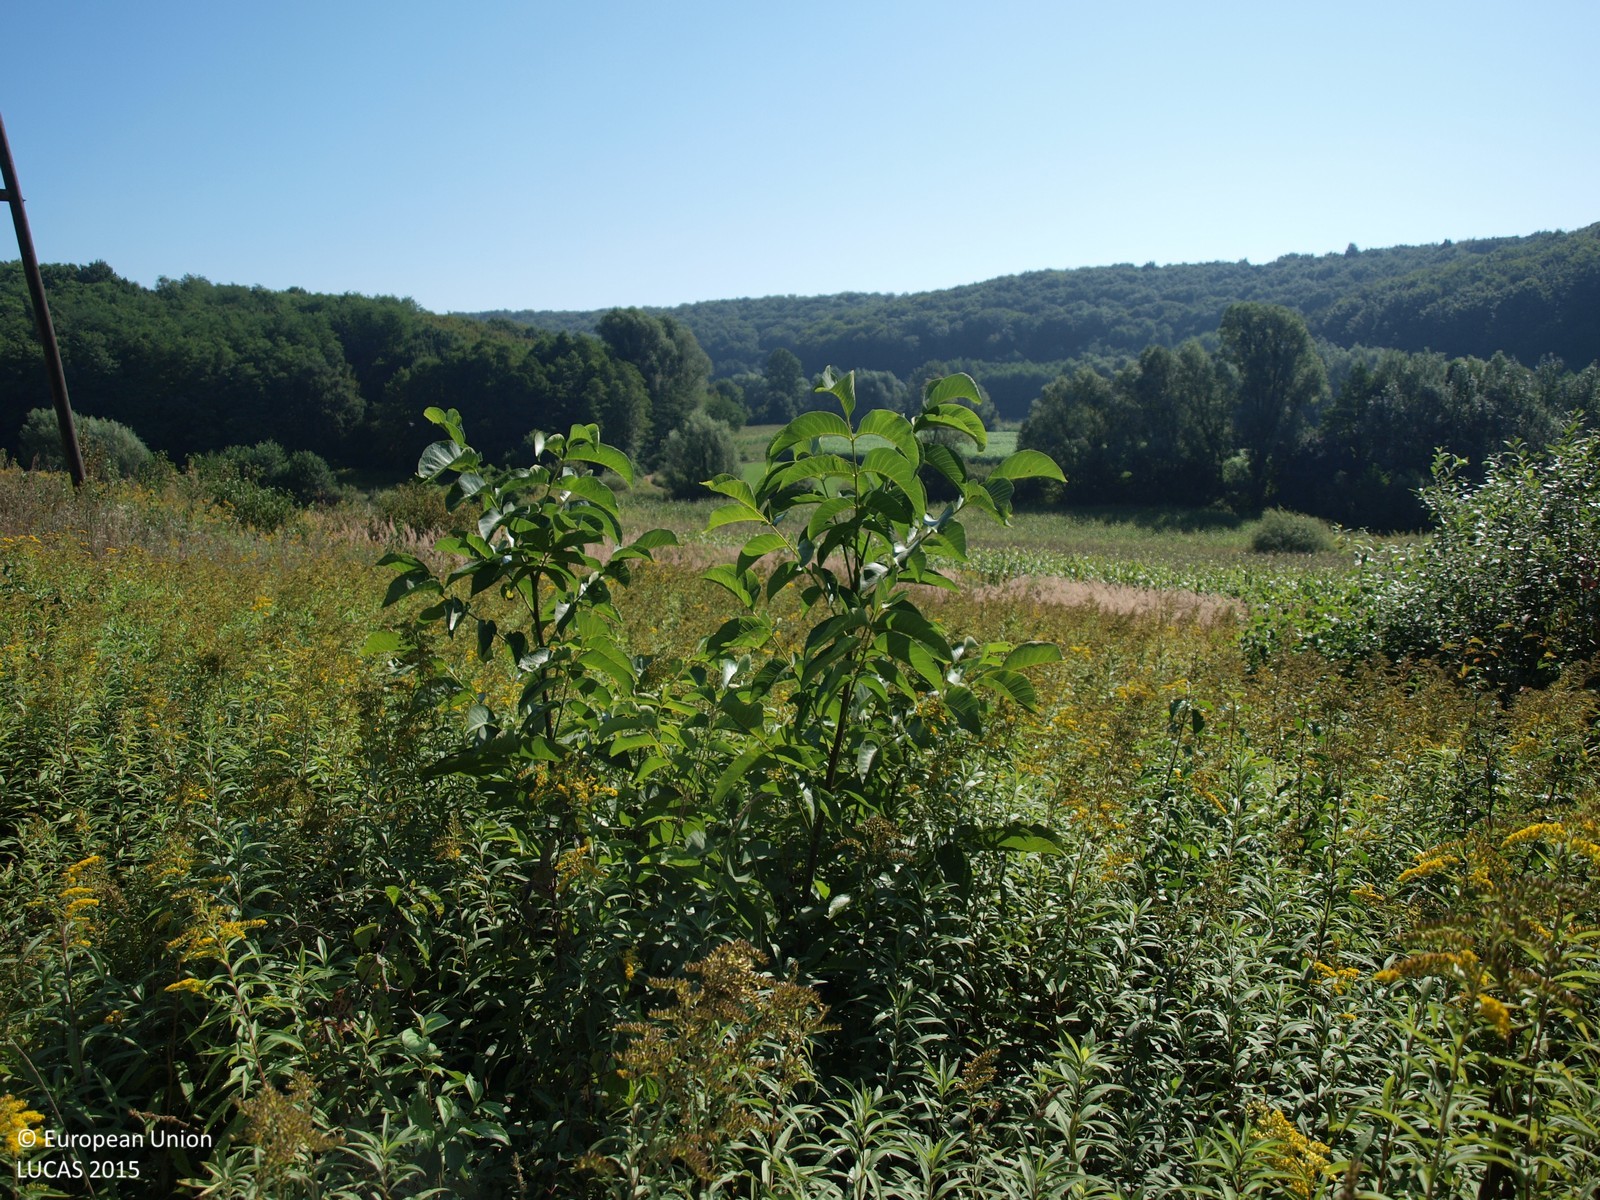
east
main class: Shrubland
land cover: Shrubland with sparse tree cover
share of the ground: > 75 %
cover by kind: shrubs 95 %, broadleaved forest trees 5 %
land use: Semi-natural and natural areas not in use
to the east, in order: Shrubland with sparse tree cover; Electric lines; Shrubland with sparse tree cover; Maize; Other fresh vegetables; Grassland without tree/shrub cover; Shrubland with sparse tree cover; Maize; Abandoned hedges; Rivers and streams; Grassland without tree/shrub cover; Maize
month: August
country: HR
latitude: 46.0909
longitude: 16.6353
